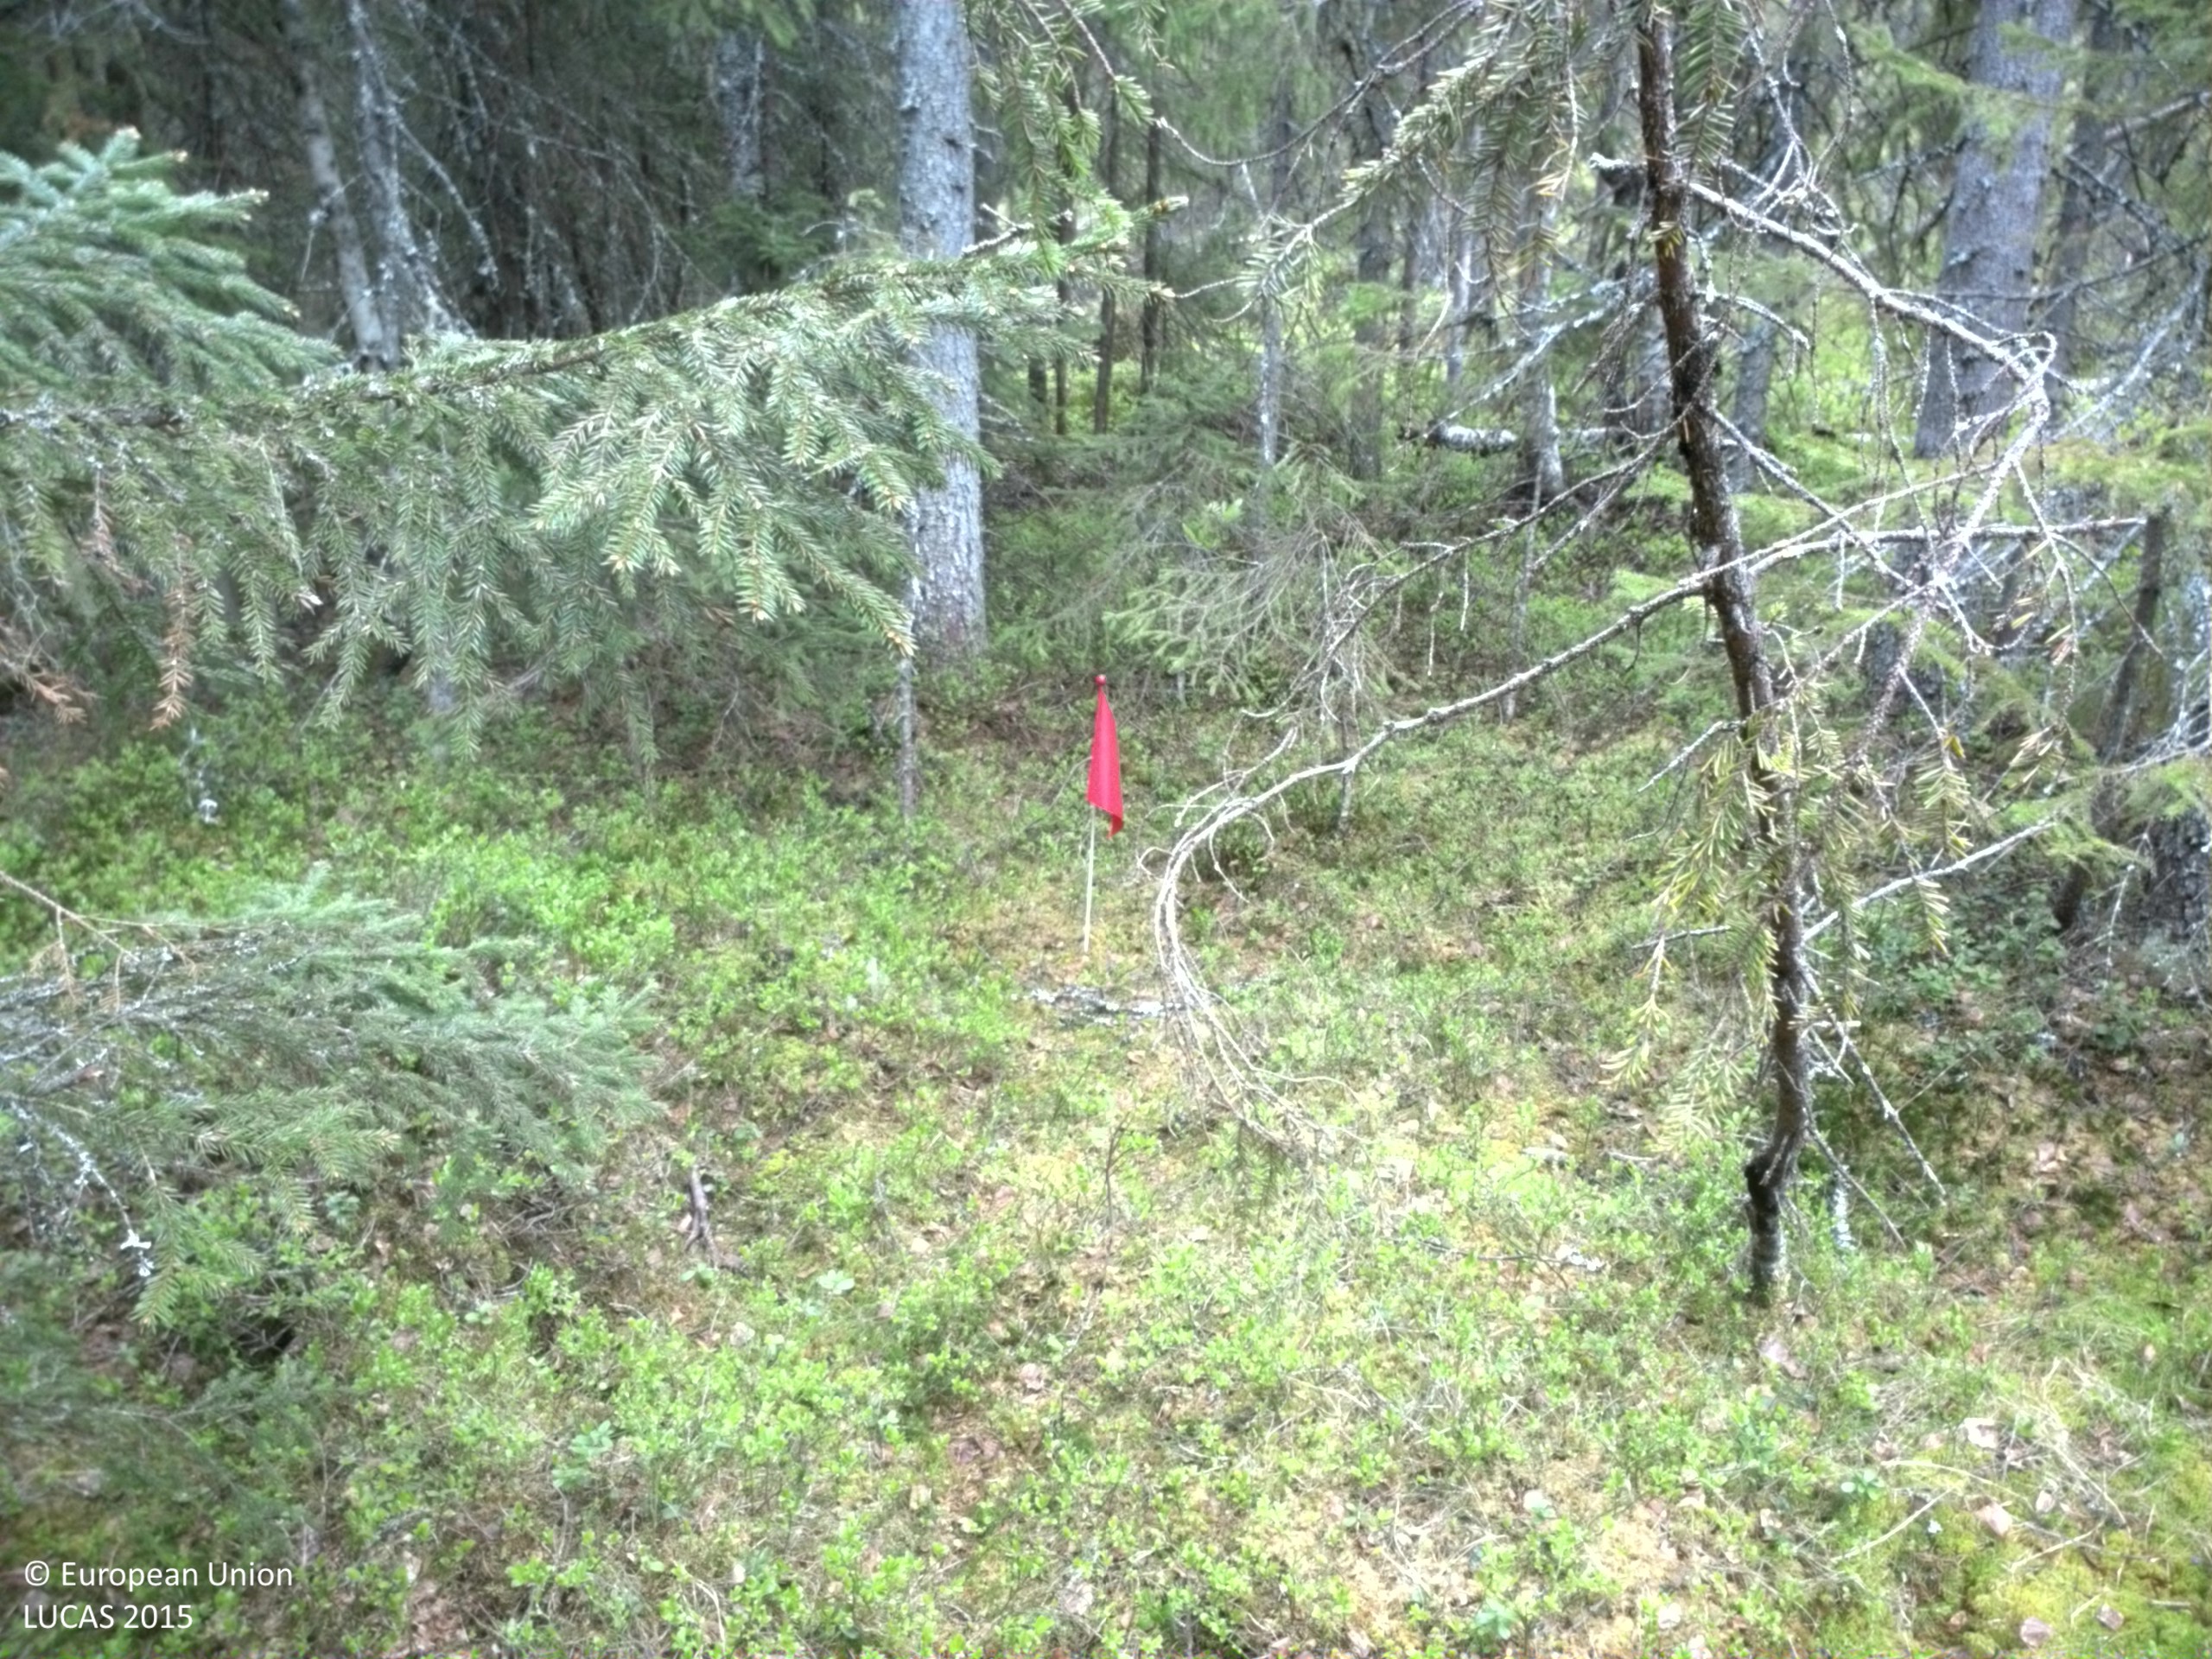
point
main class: Woodland
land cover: Spruce dominated coniferous woodland
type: boreal forest
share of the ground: 50 - 75 %
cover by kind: coniferous forest trees 60 %, shrubs 30 %, lichens and mosses 10 %
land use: Forestry
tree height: > 5 m
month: June
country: SE
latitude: 62.9234
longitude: 17.3225
